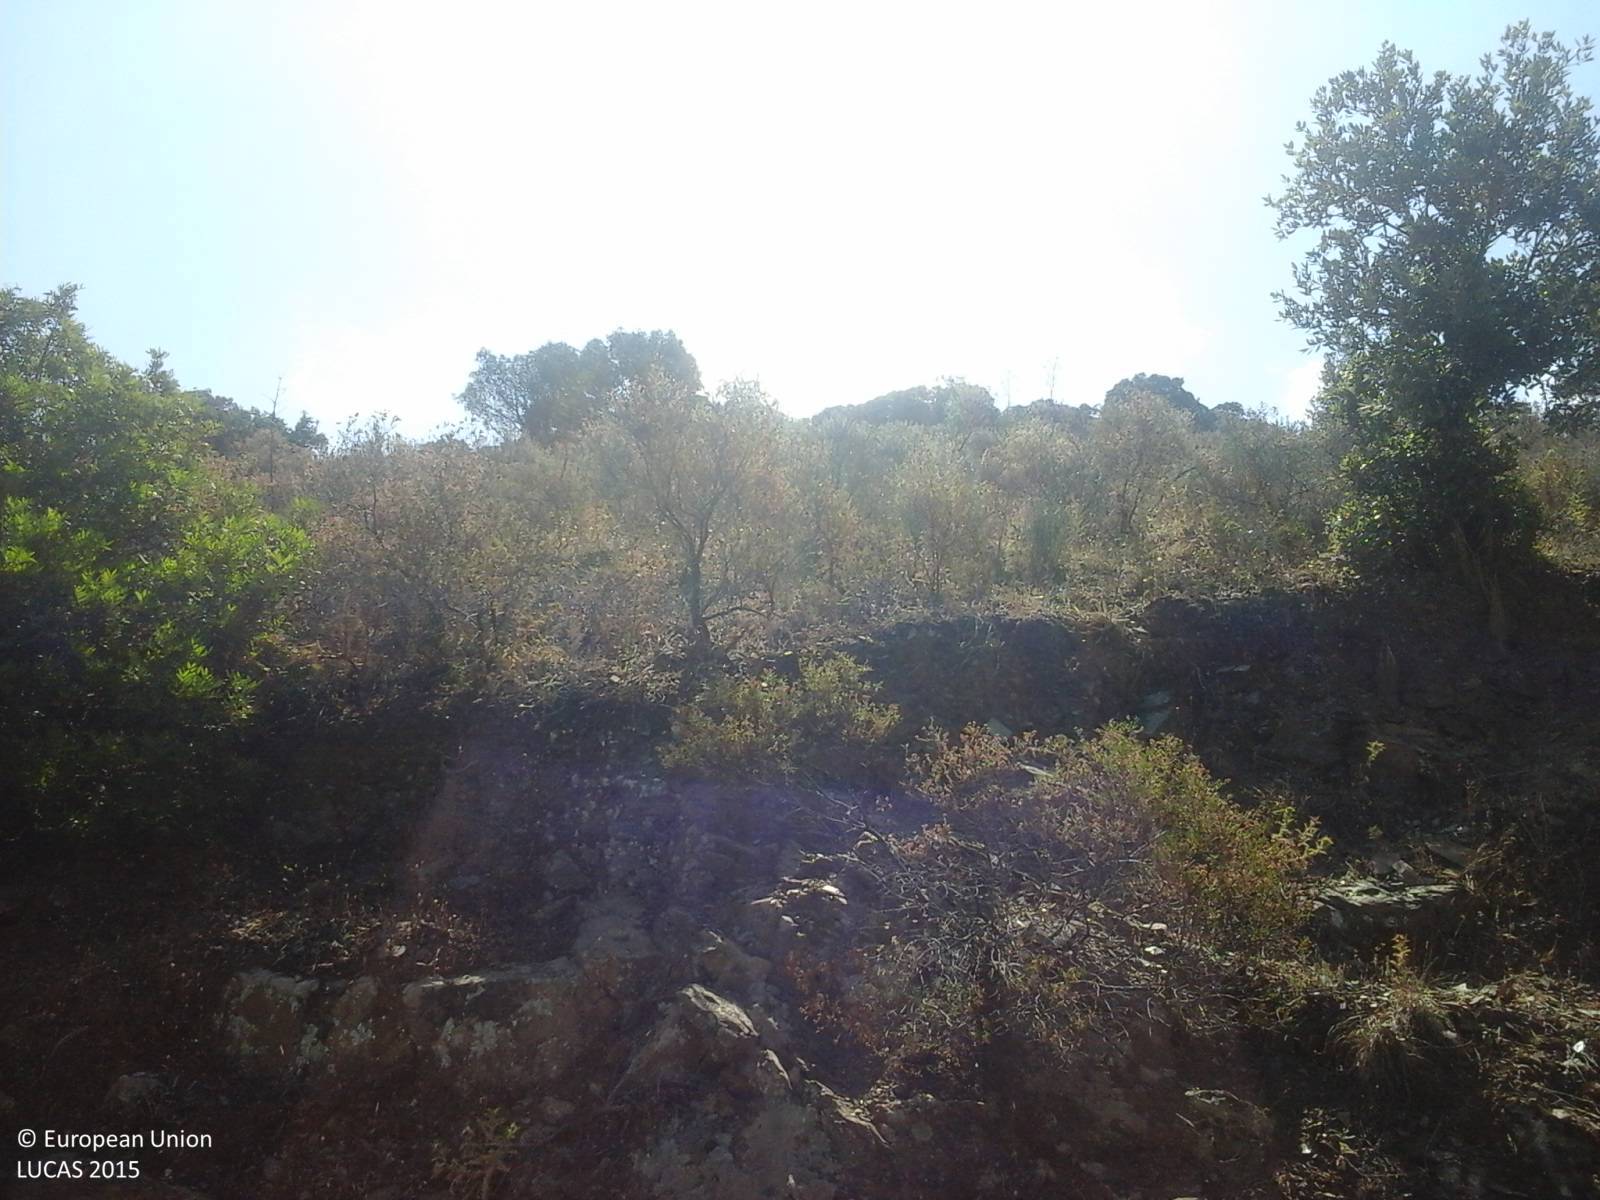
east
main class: Shrubland
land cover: Shrubland with sparse tree cover
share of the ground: > 75 %
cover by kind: shrubs 75 %, herbaceous plants 15 %, broadleaved forest trees 5 %, unconsolidated bare surface 5 %
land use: Agriculture (excluding fallow land and kitchen gardens)
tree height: < 5 m
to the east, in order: Shrubland with sparse tree cover; Broadleaved woodland; Paved roads, cycling and walking lanes; Shrubland without tree cover; Shrubland with sparse tree cover; Shrubland without tree cover
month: July
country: IT
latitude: 39.4331
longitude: 9.5265
